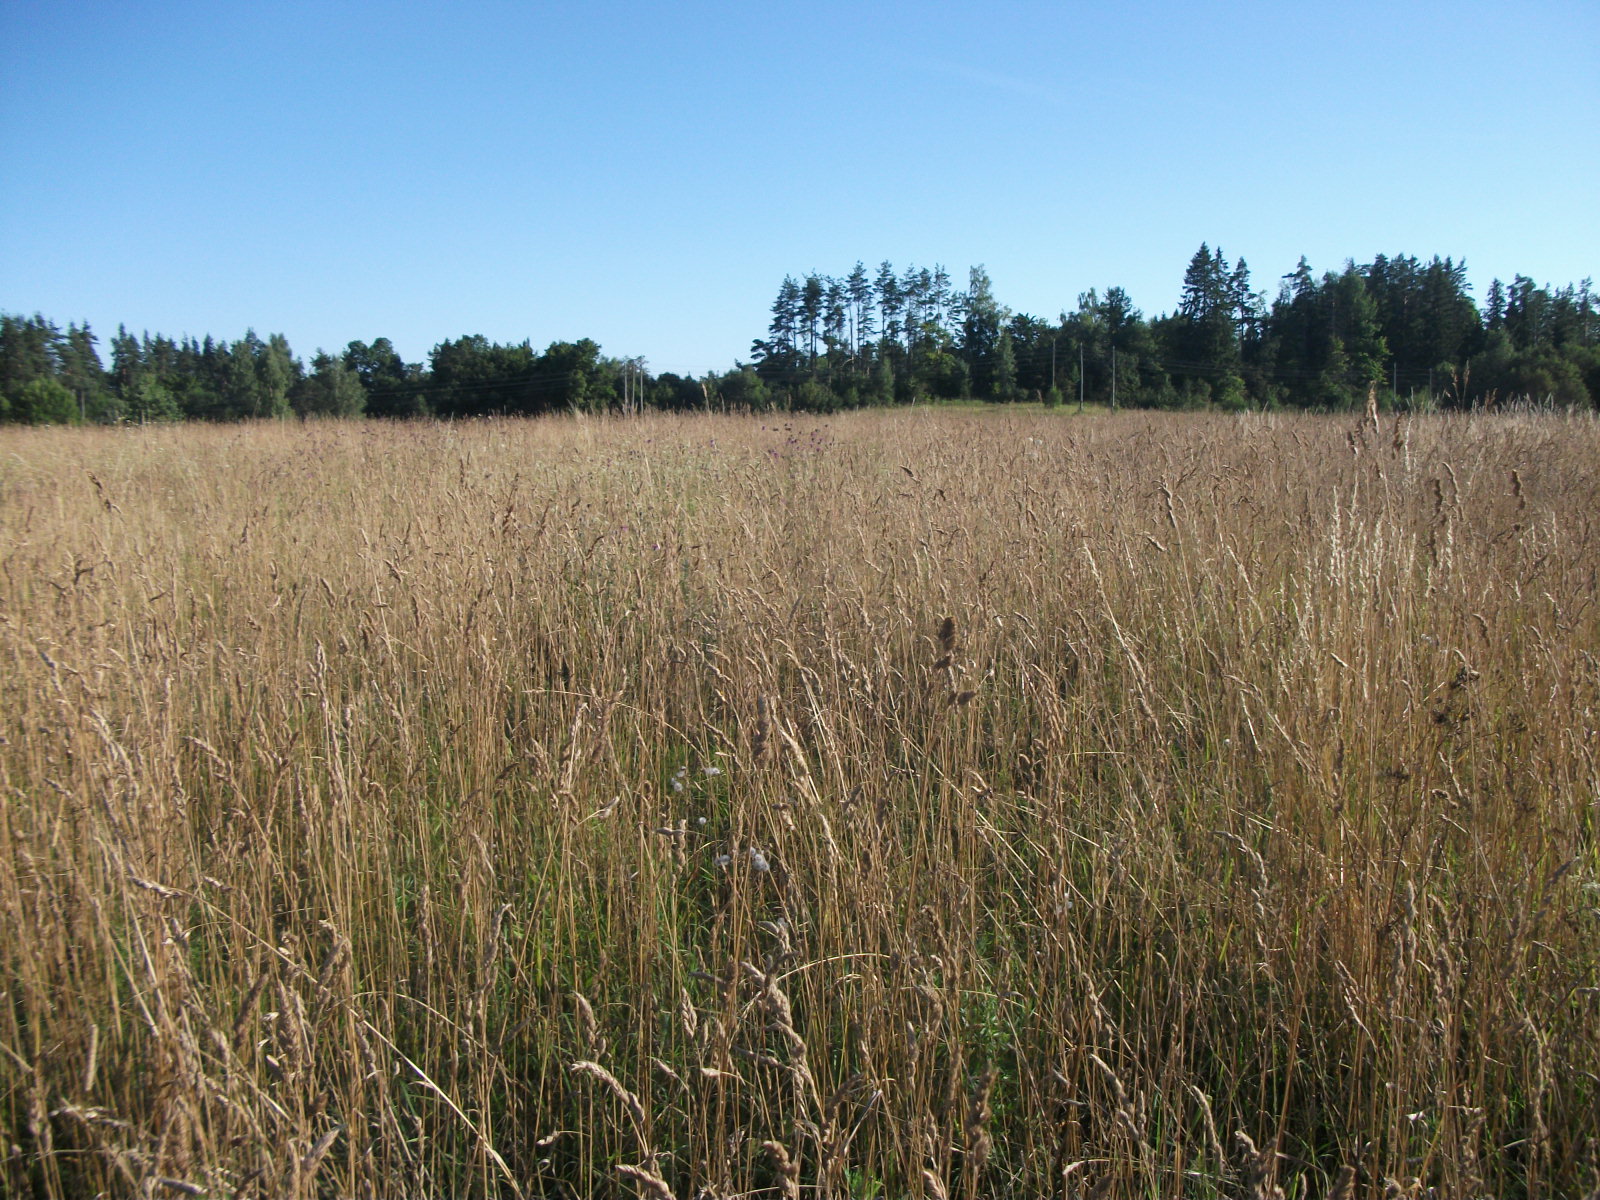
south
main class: Grassland
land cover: Grassland without tree/shrub cover
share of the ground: > 75 %
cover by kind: herbaceous plants 100 %
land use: Agriculture (excluding fallow land and kitchen gardens)
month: August
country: LV
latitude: 56.8726
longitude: 26.2332
